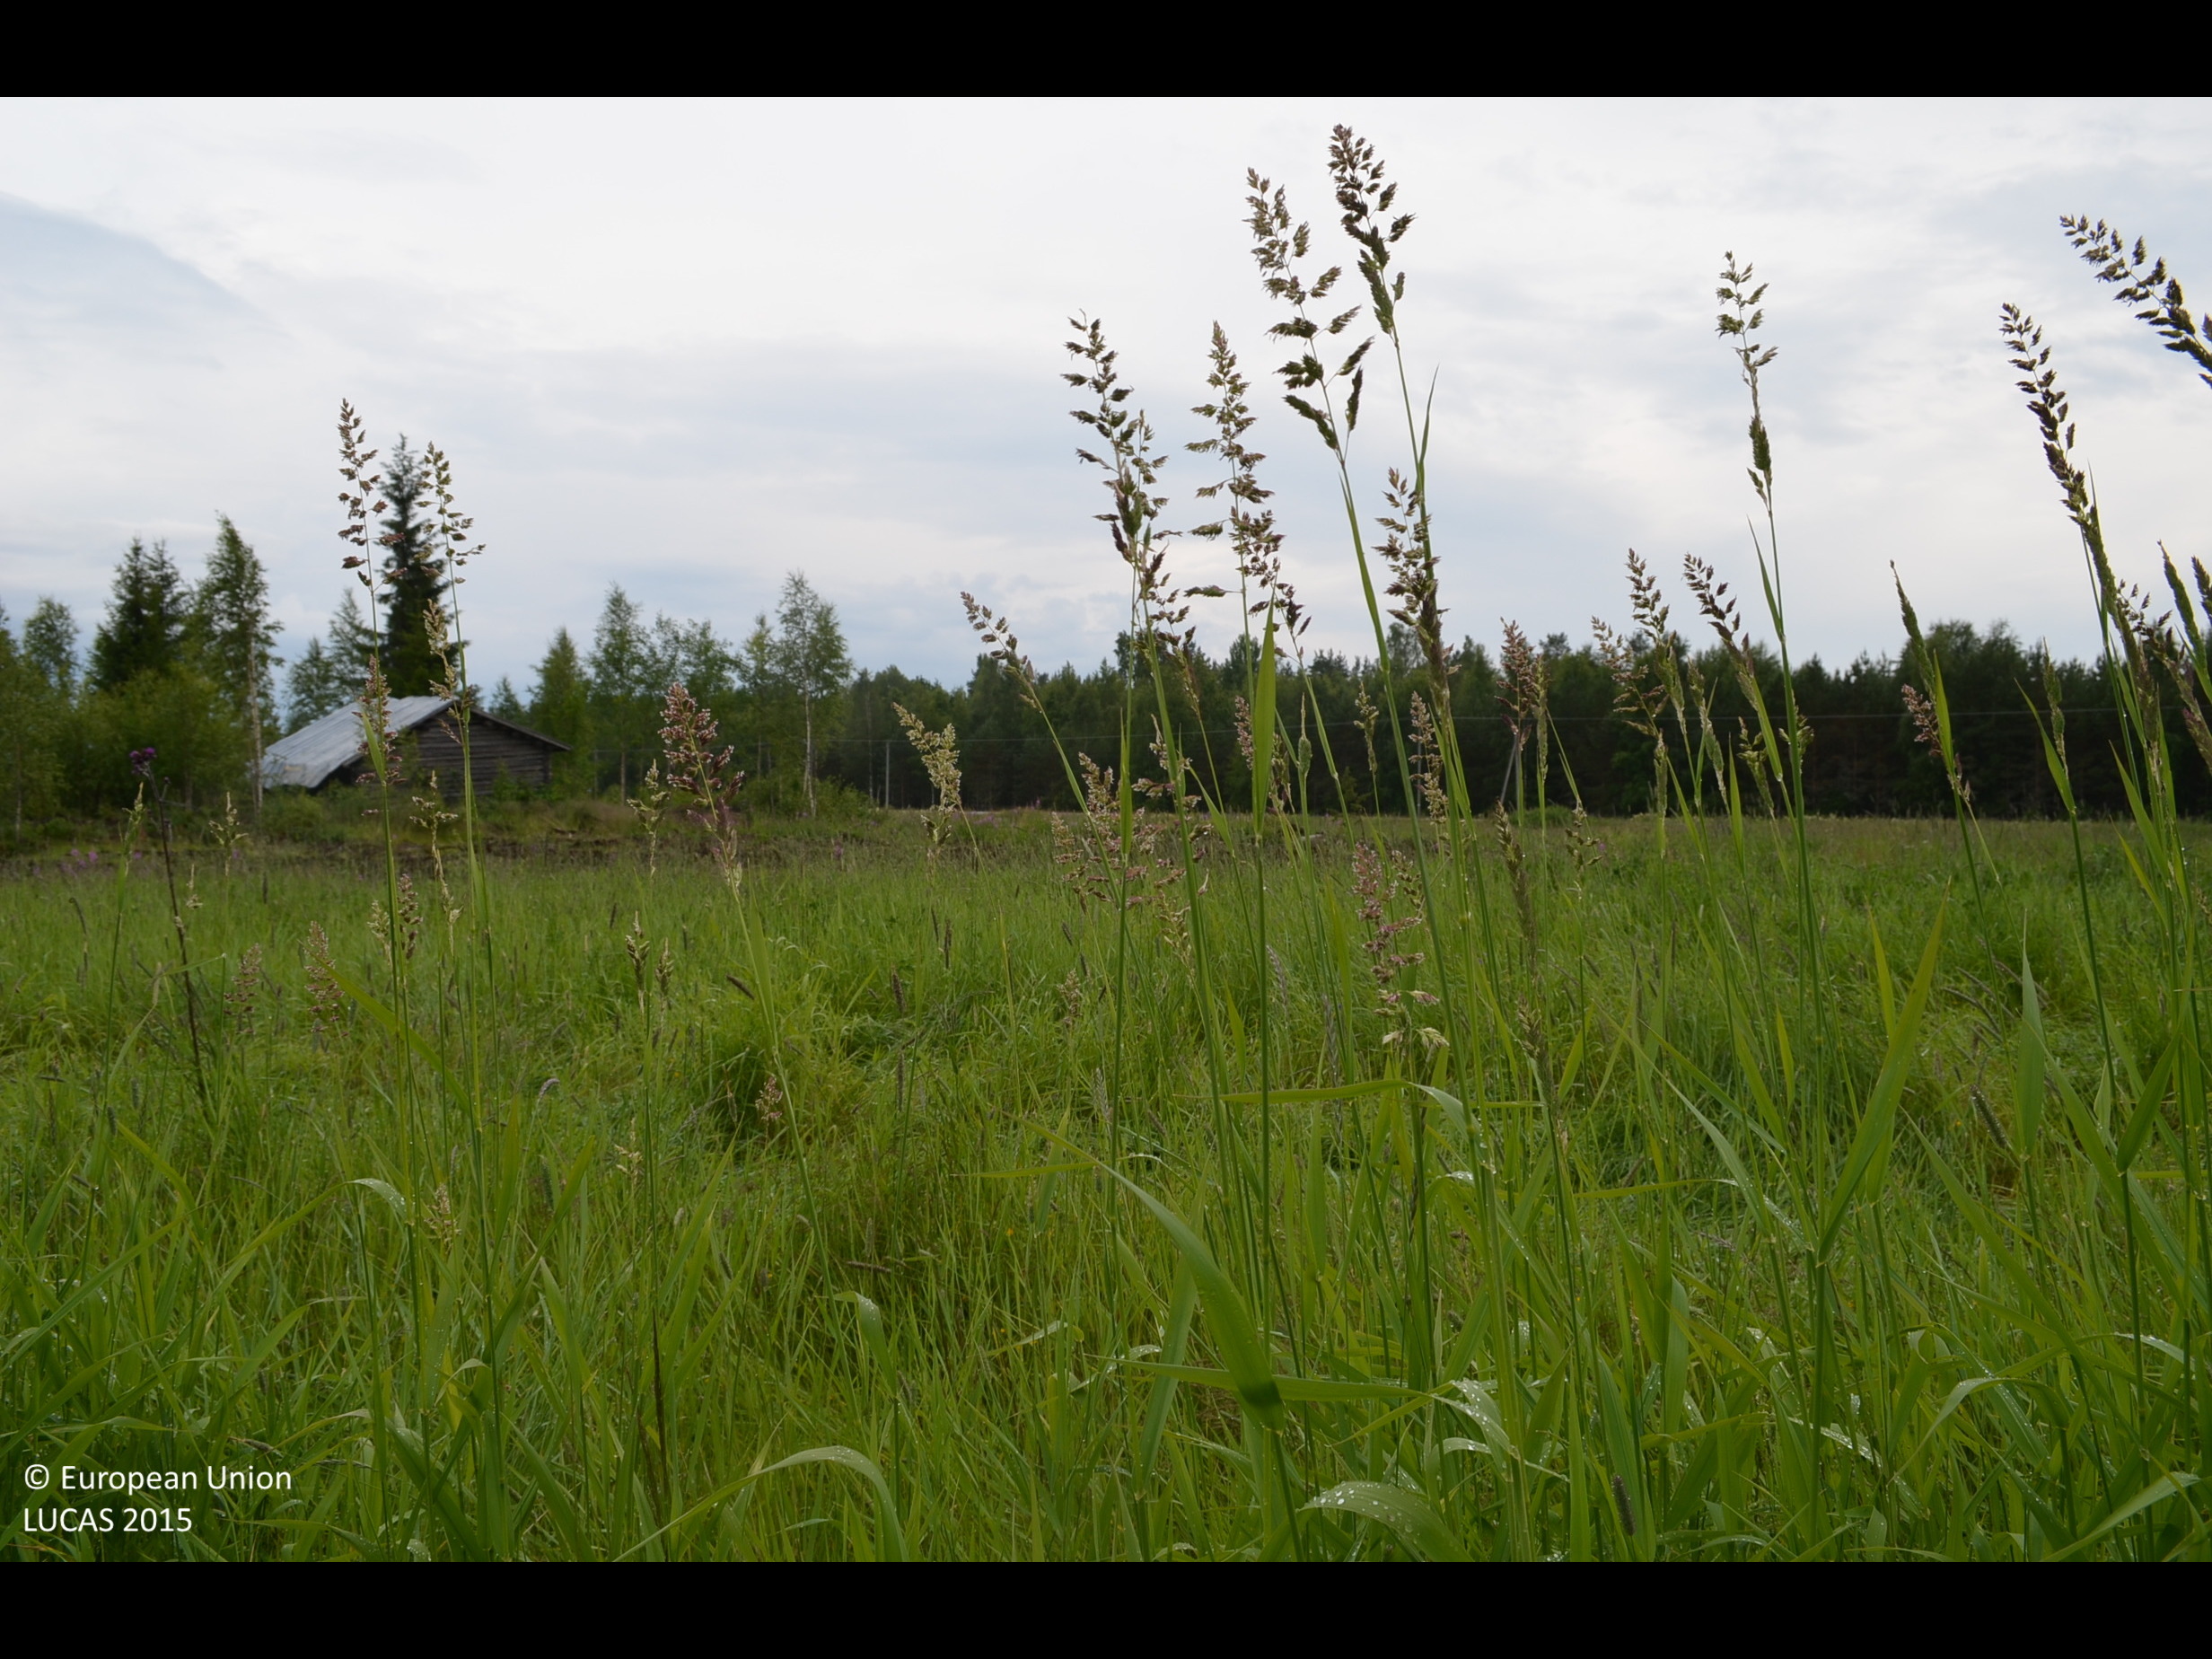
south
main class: Cropland
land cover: Temporary grasslands
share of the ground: > 75 %
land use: Agriculture (excluding fallow land and kitchen gardens)
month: July
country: FI
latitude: 62.2893
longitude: 23.3521
